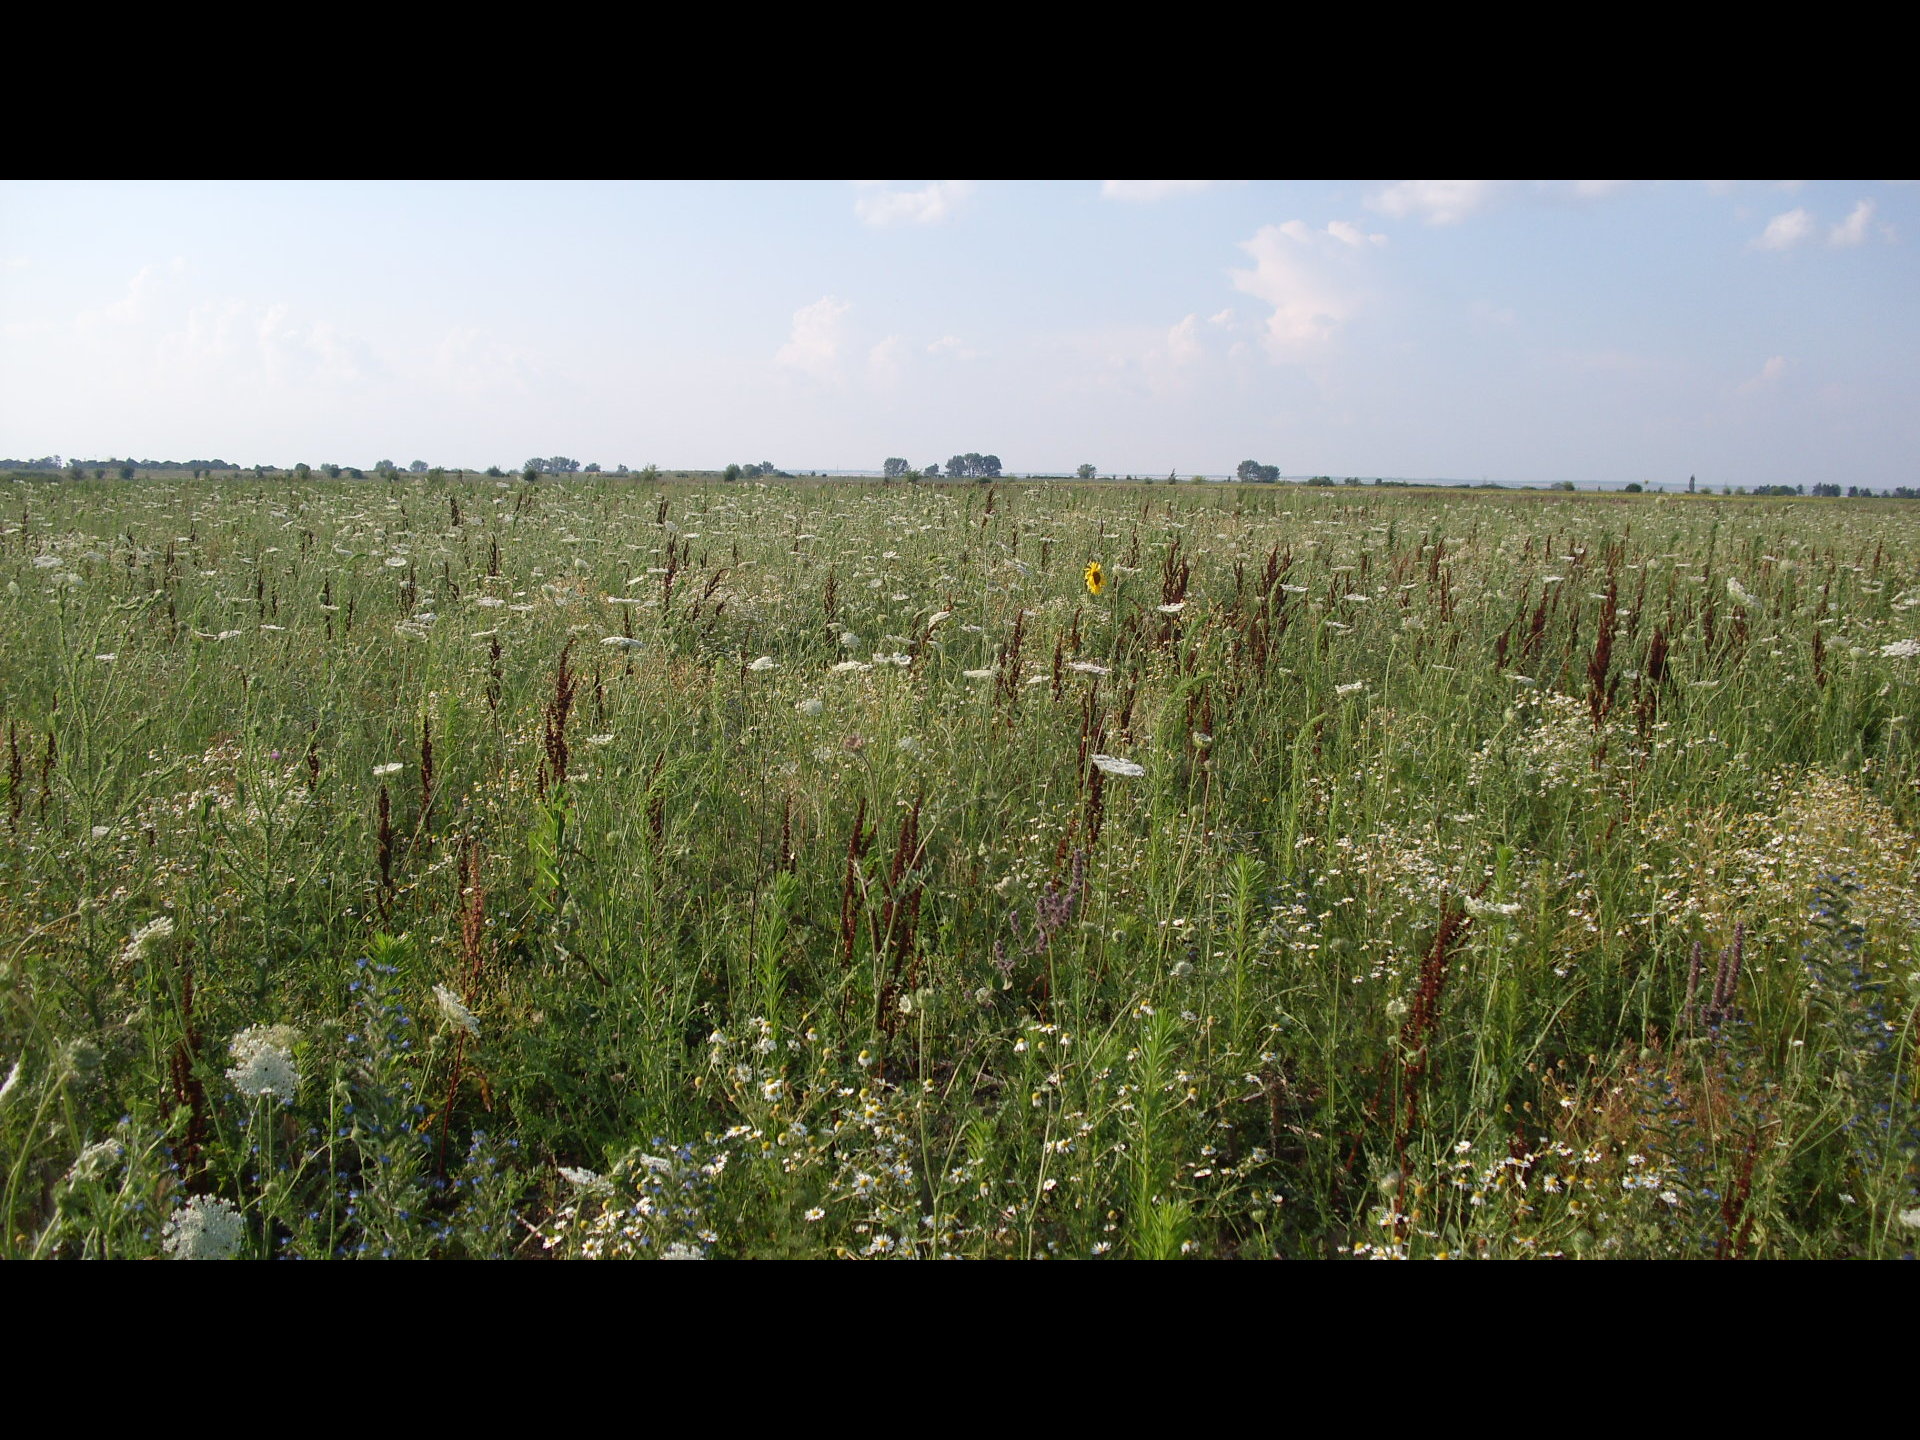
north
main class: Grassland
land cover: Spontaneously vegetated surfaces
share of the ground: > 75 %
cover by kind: herbaceous plants 100 %
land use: Fallow land
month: July
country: BG
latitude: 43.6509
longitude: 23.0450
